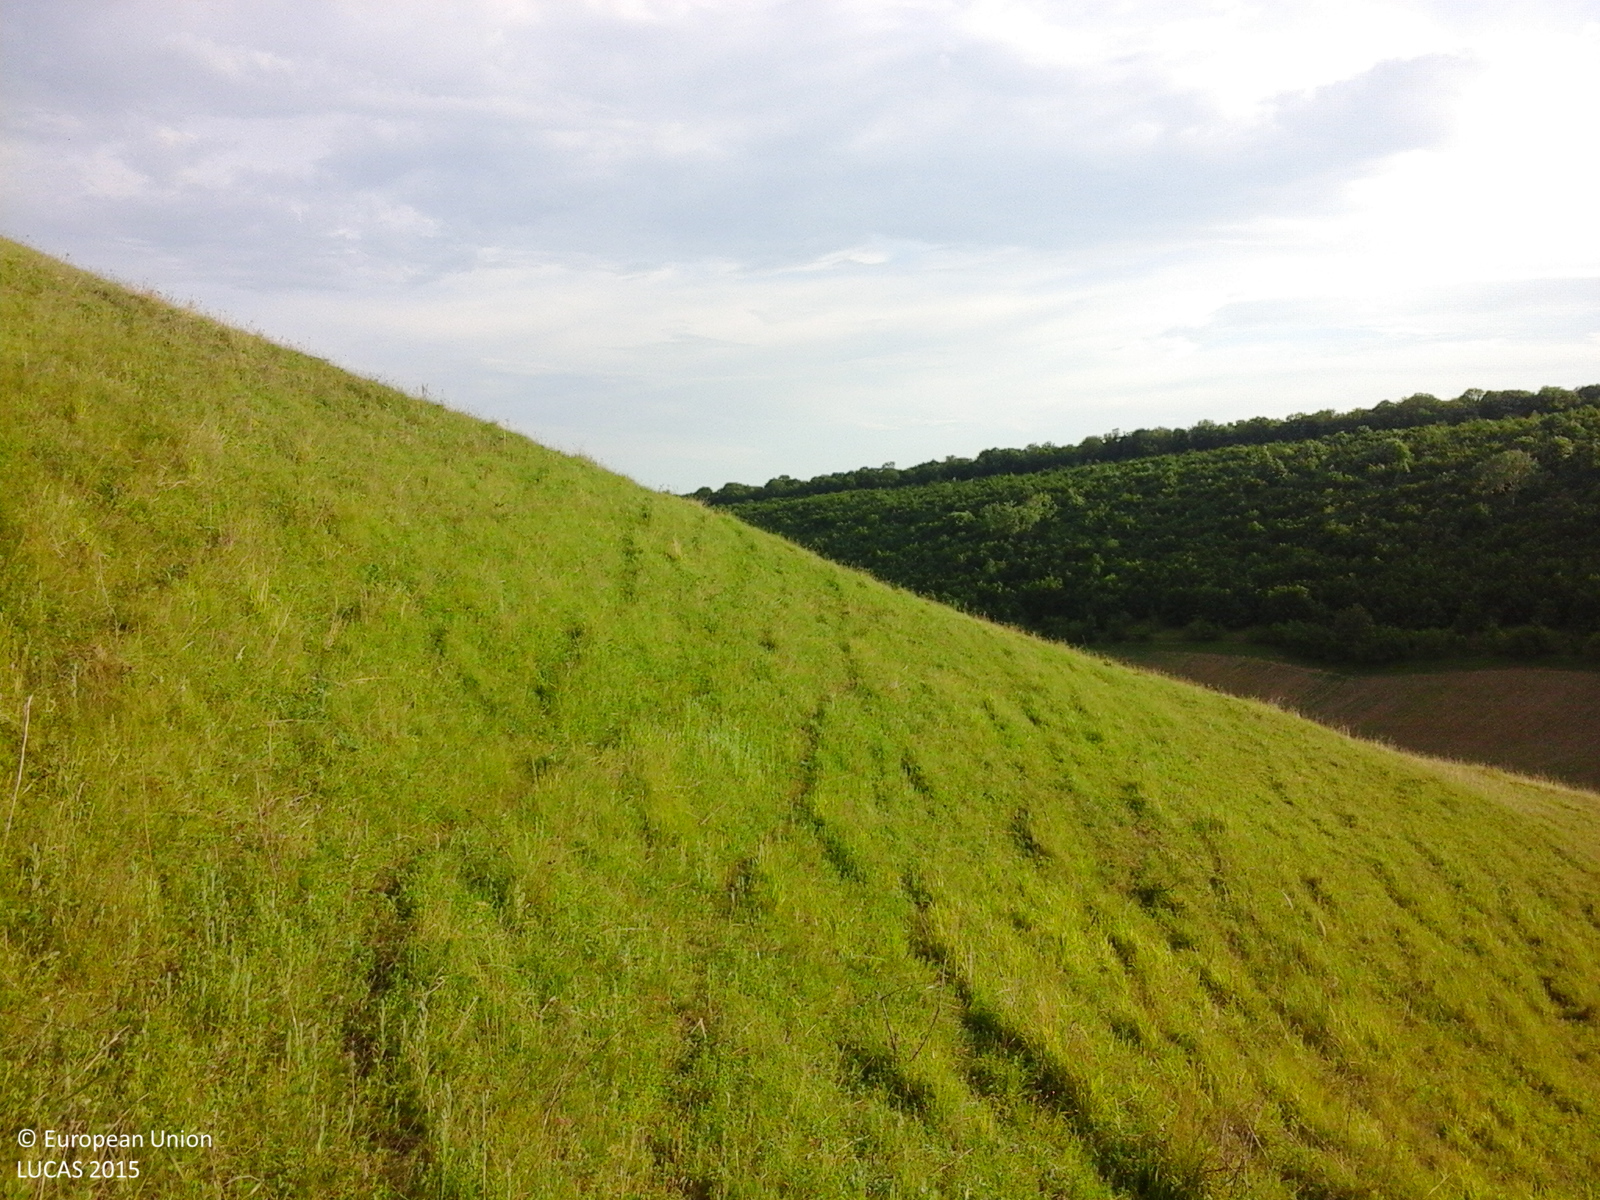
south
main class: Grassland
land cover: Grassland without tree/shrub cover
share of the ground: > 75 %
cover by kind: herbaceous plants 100 %
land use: Agriculture (excluding fallow land and kitchen gardens)
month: June
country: RO
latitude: 46.4221
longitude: 27.0510
